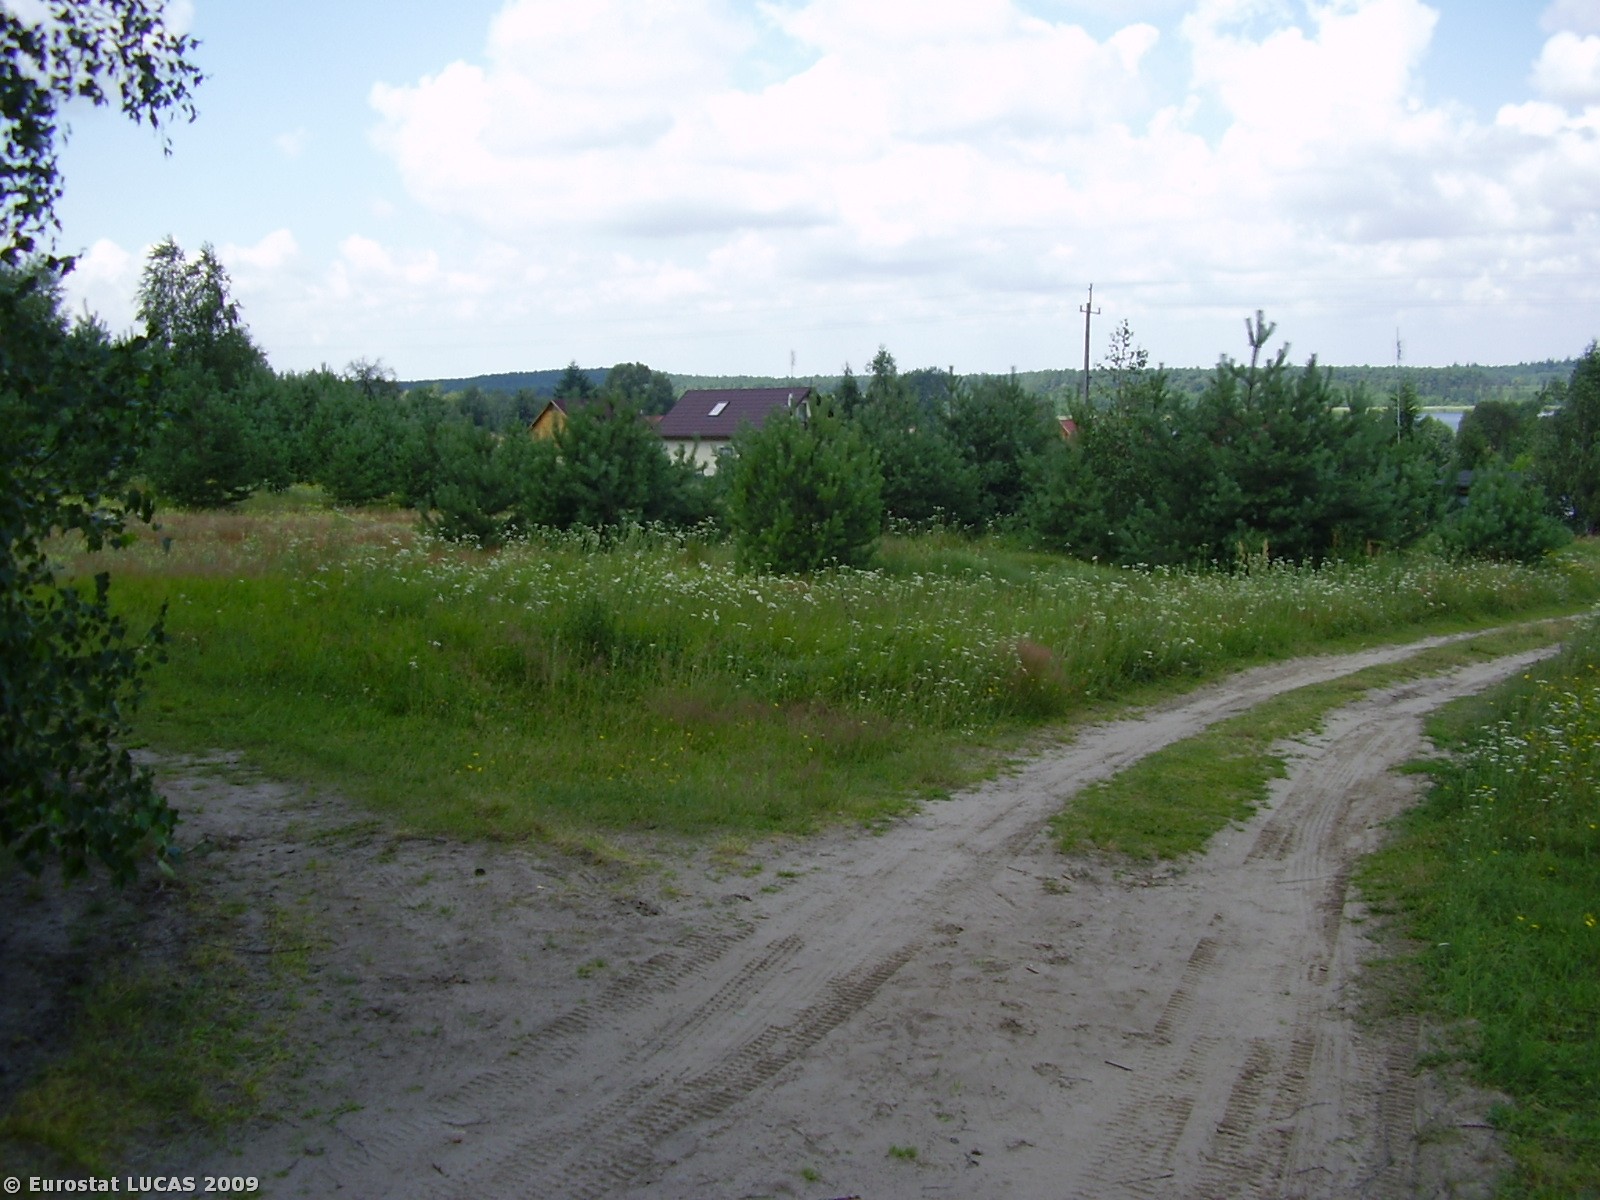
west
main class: Grassland
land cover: Grassland without tree/shrub cover
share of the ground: > 75 %
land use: Holiday camps
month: July
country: PL
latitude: 51.9394
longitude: 16.3054
